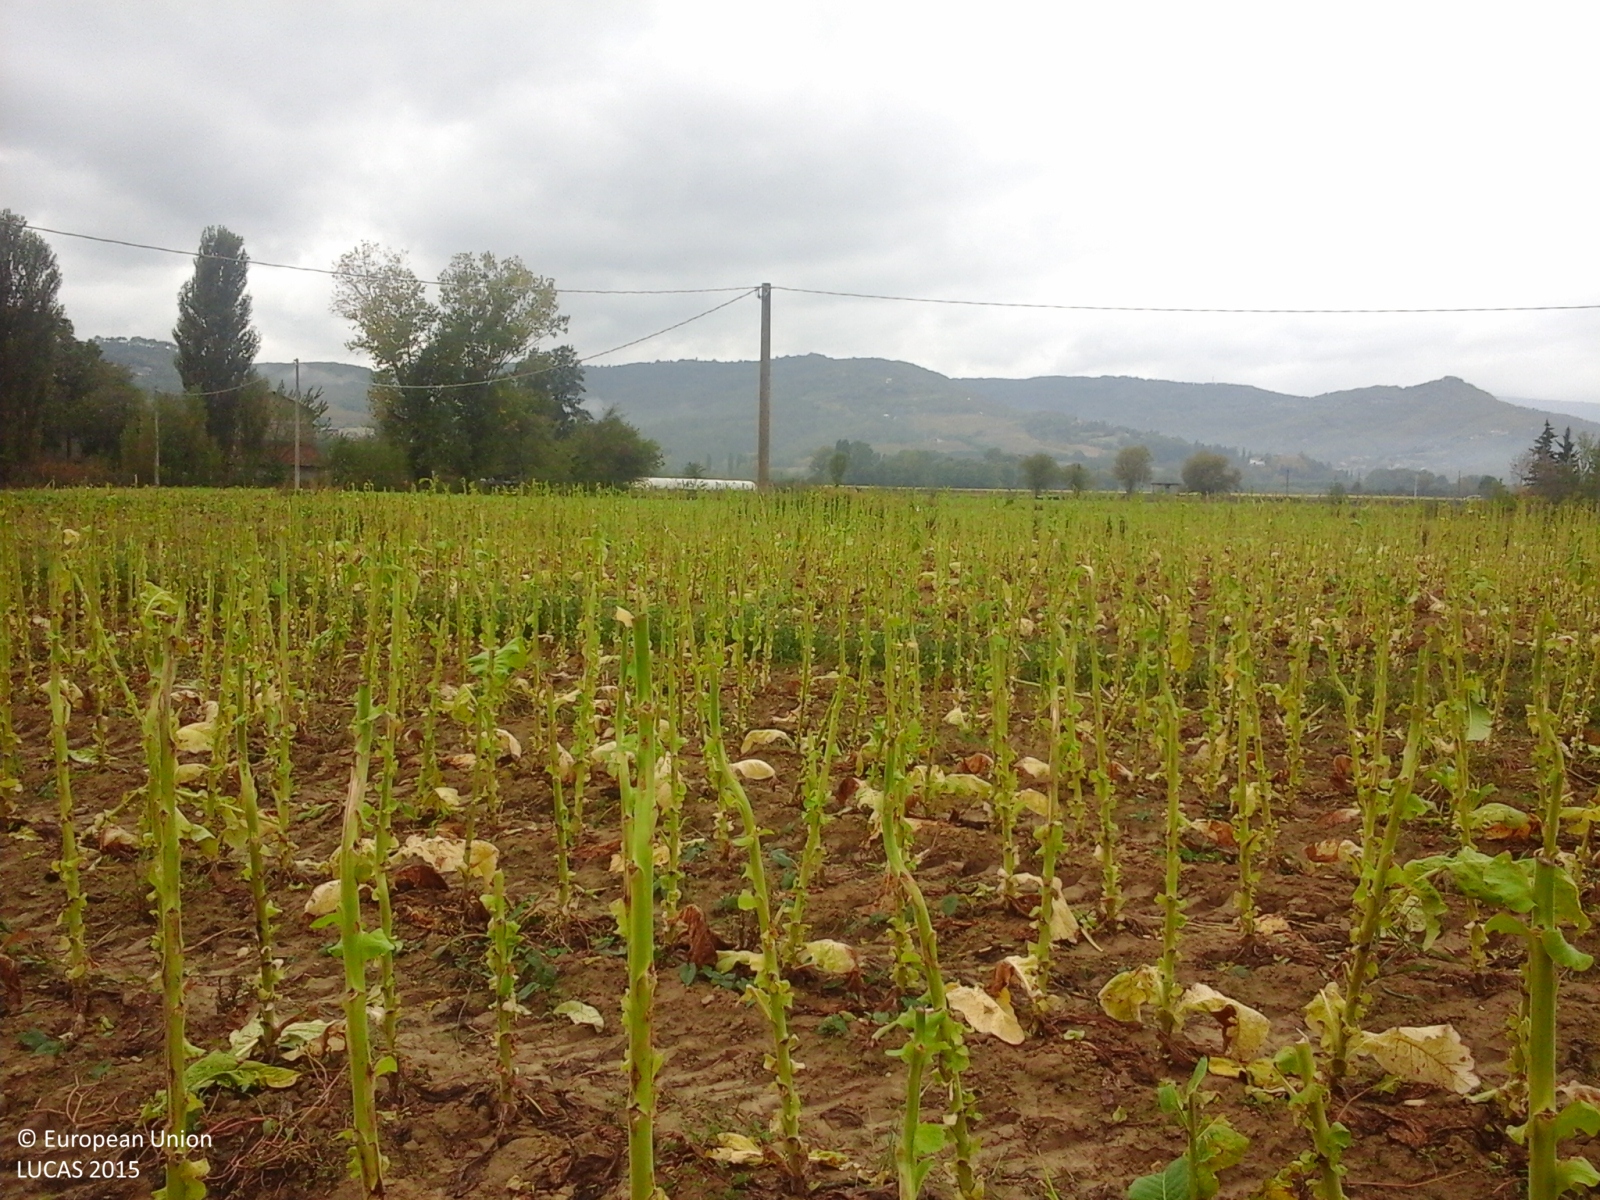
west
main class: Cropland
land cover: Tobacco
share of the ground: > 75 %
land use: Agriculture (excluding fallow land and kitchen gardens)
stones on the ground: < 10 %
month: October
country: IT
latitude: 43.3706
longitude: 12.2030
